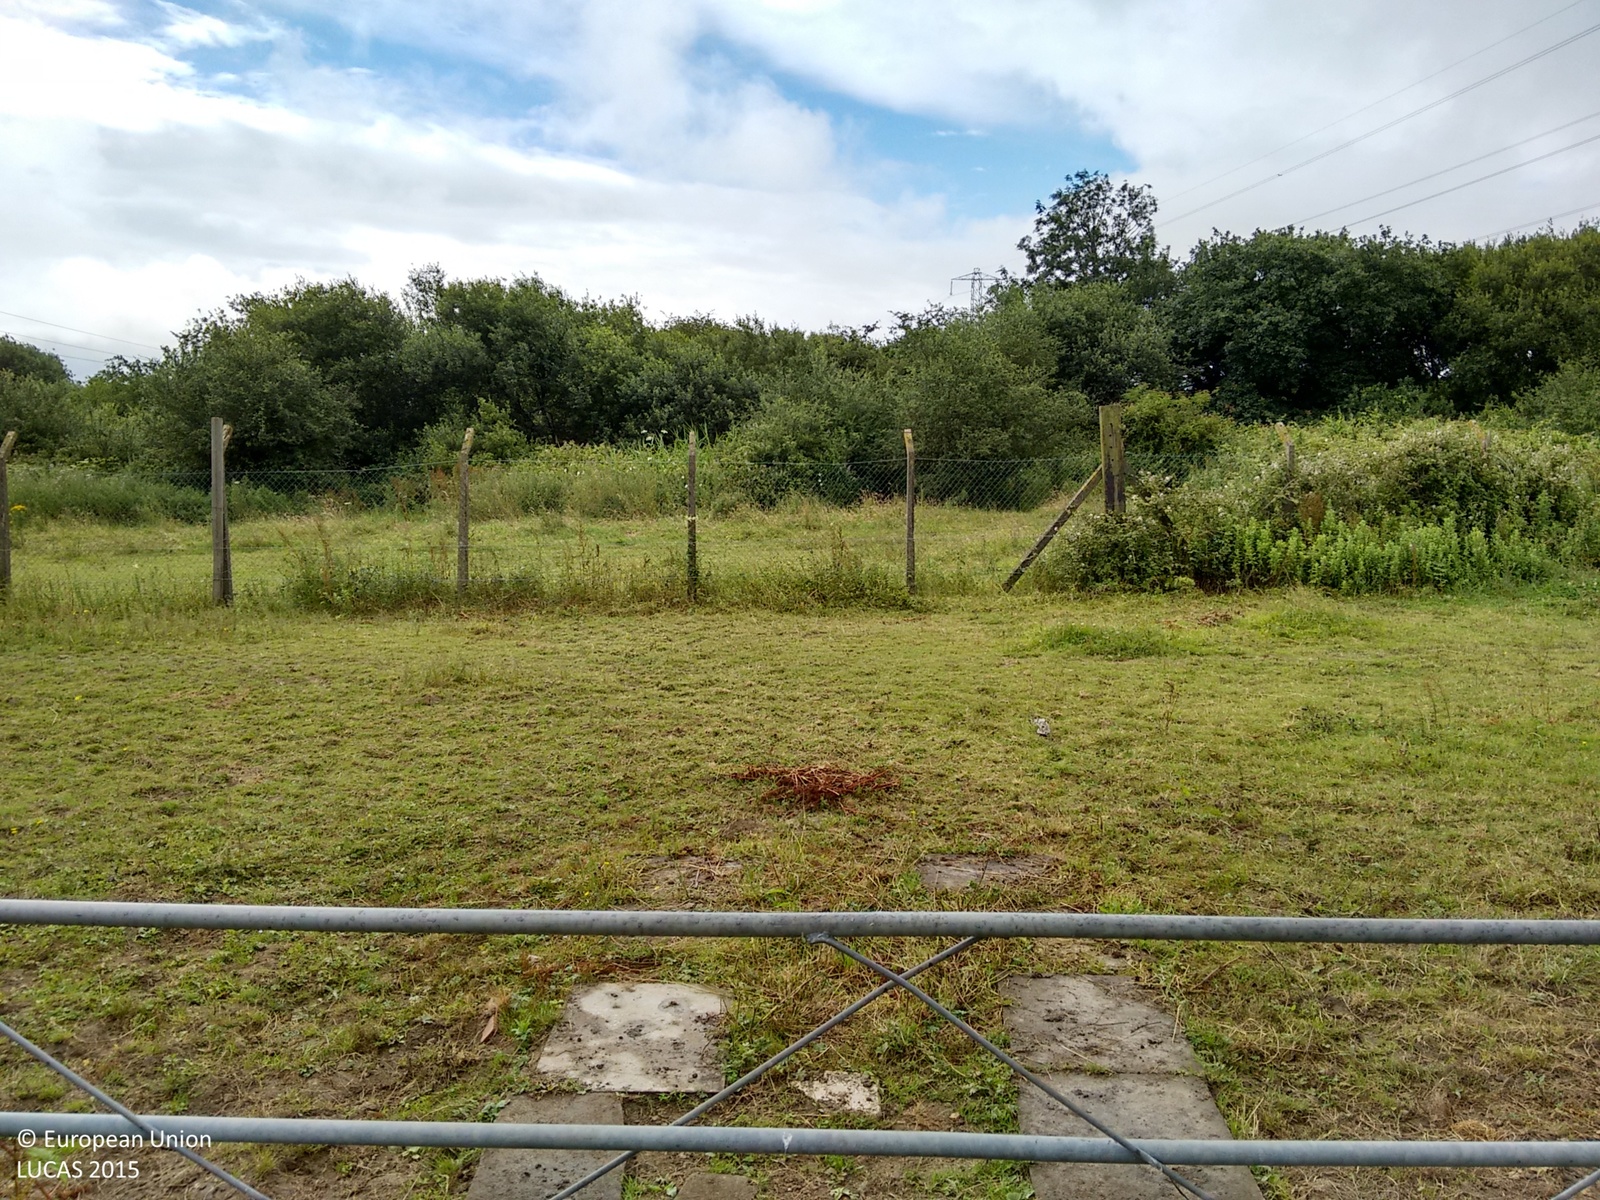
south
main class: Shrubland
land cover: Shrubland with sparse tree cover
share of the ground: > 75 %
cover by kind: shrubs 65 %, herbaceous plants 30 %, broadleaved forest trees 5 %
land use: Semi-natural and natural areas not in use
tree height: < 5 m
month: July
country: GB
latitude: 51.5543
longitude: -3.7476
